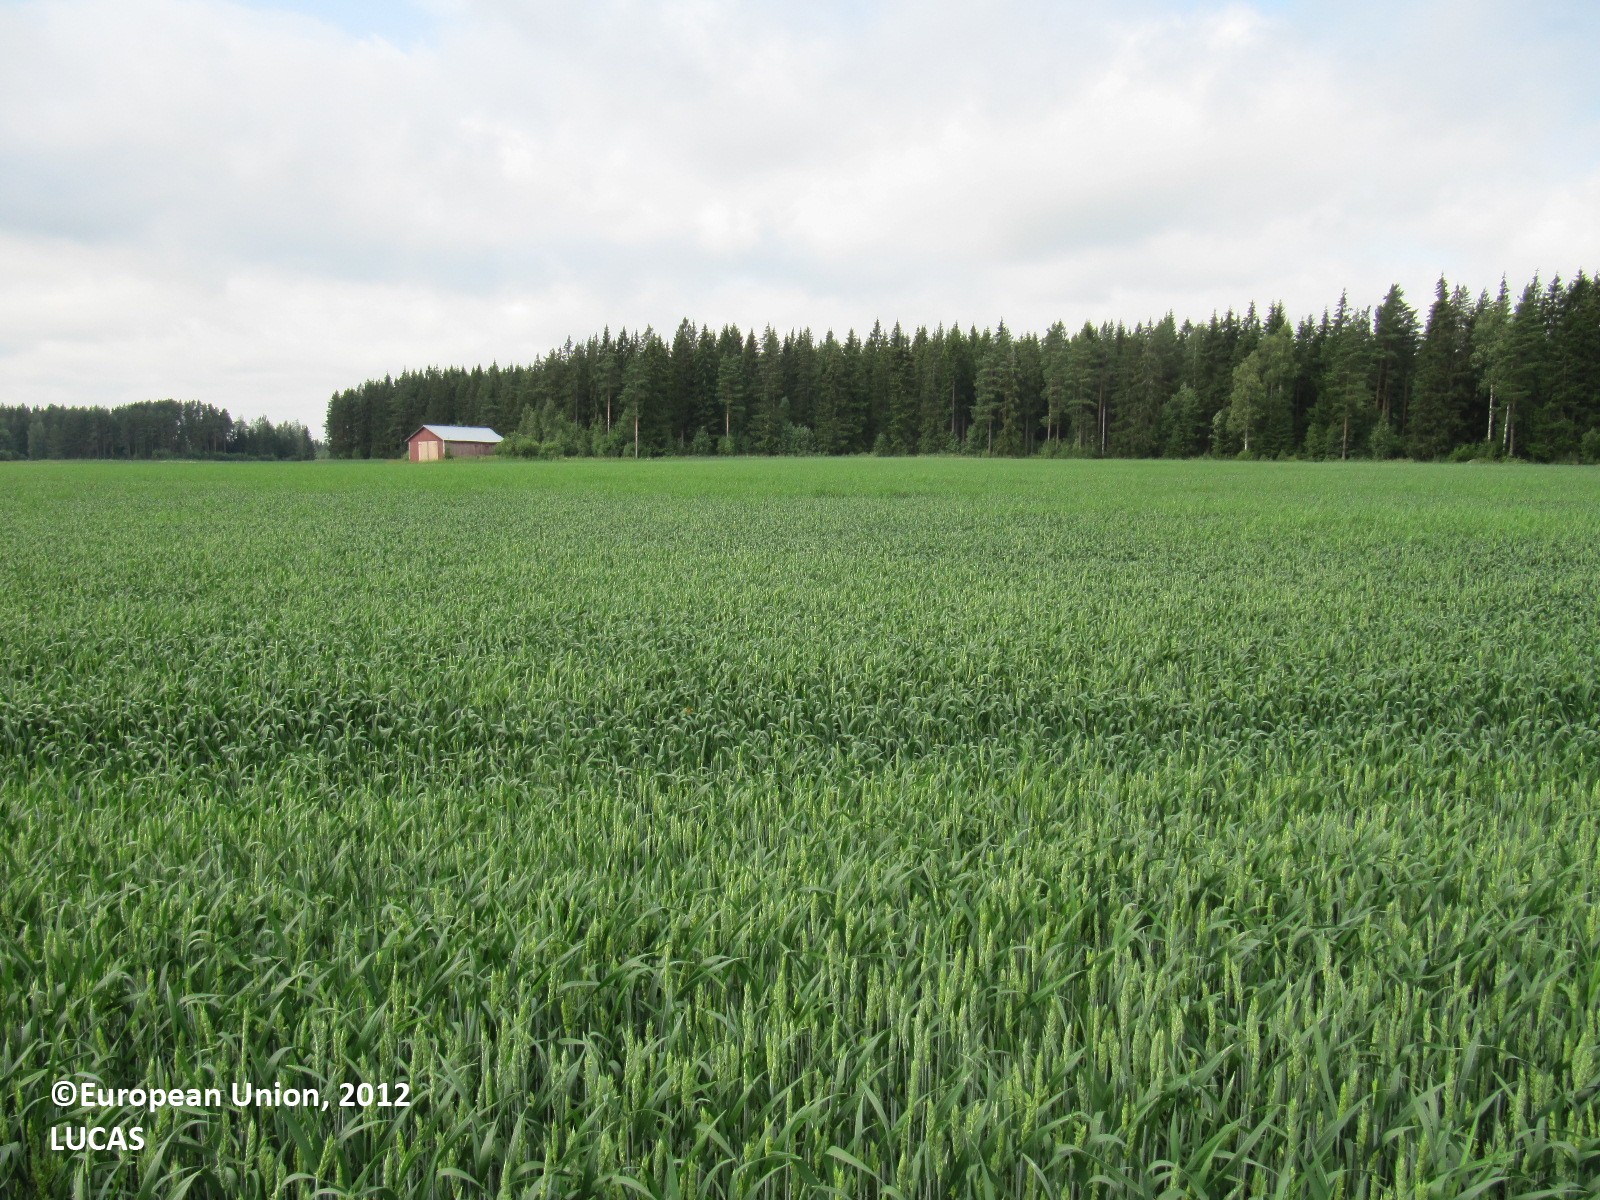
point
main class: Cropland
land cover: Common wheat
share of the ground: > 75 %
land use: Agriculture (excluding fallow land and kitchen gardens)
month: July
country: FI
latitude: 60.8277
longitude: 23.3044
